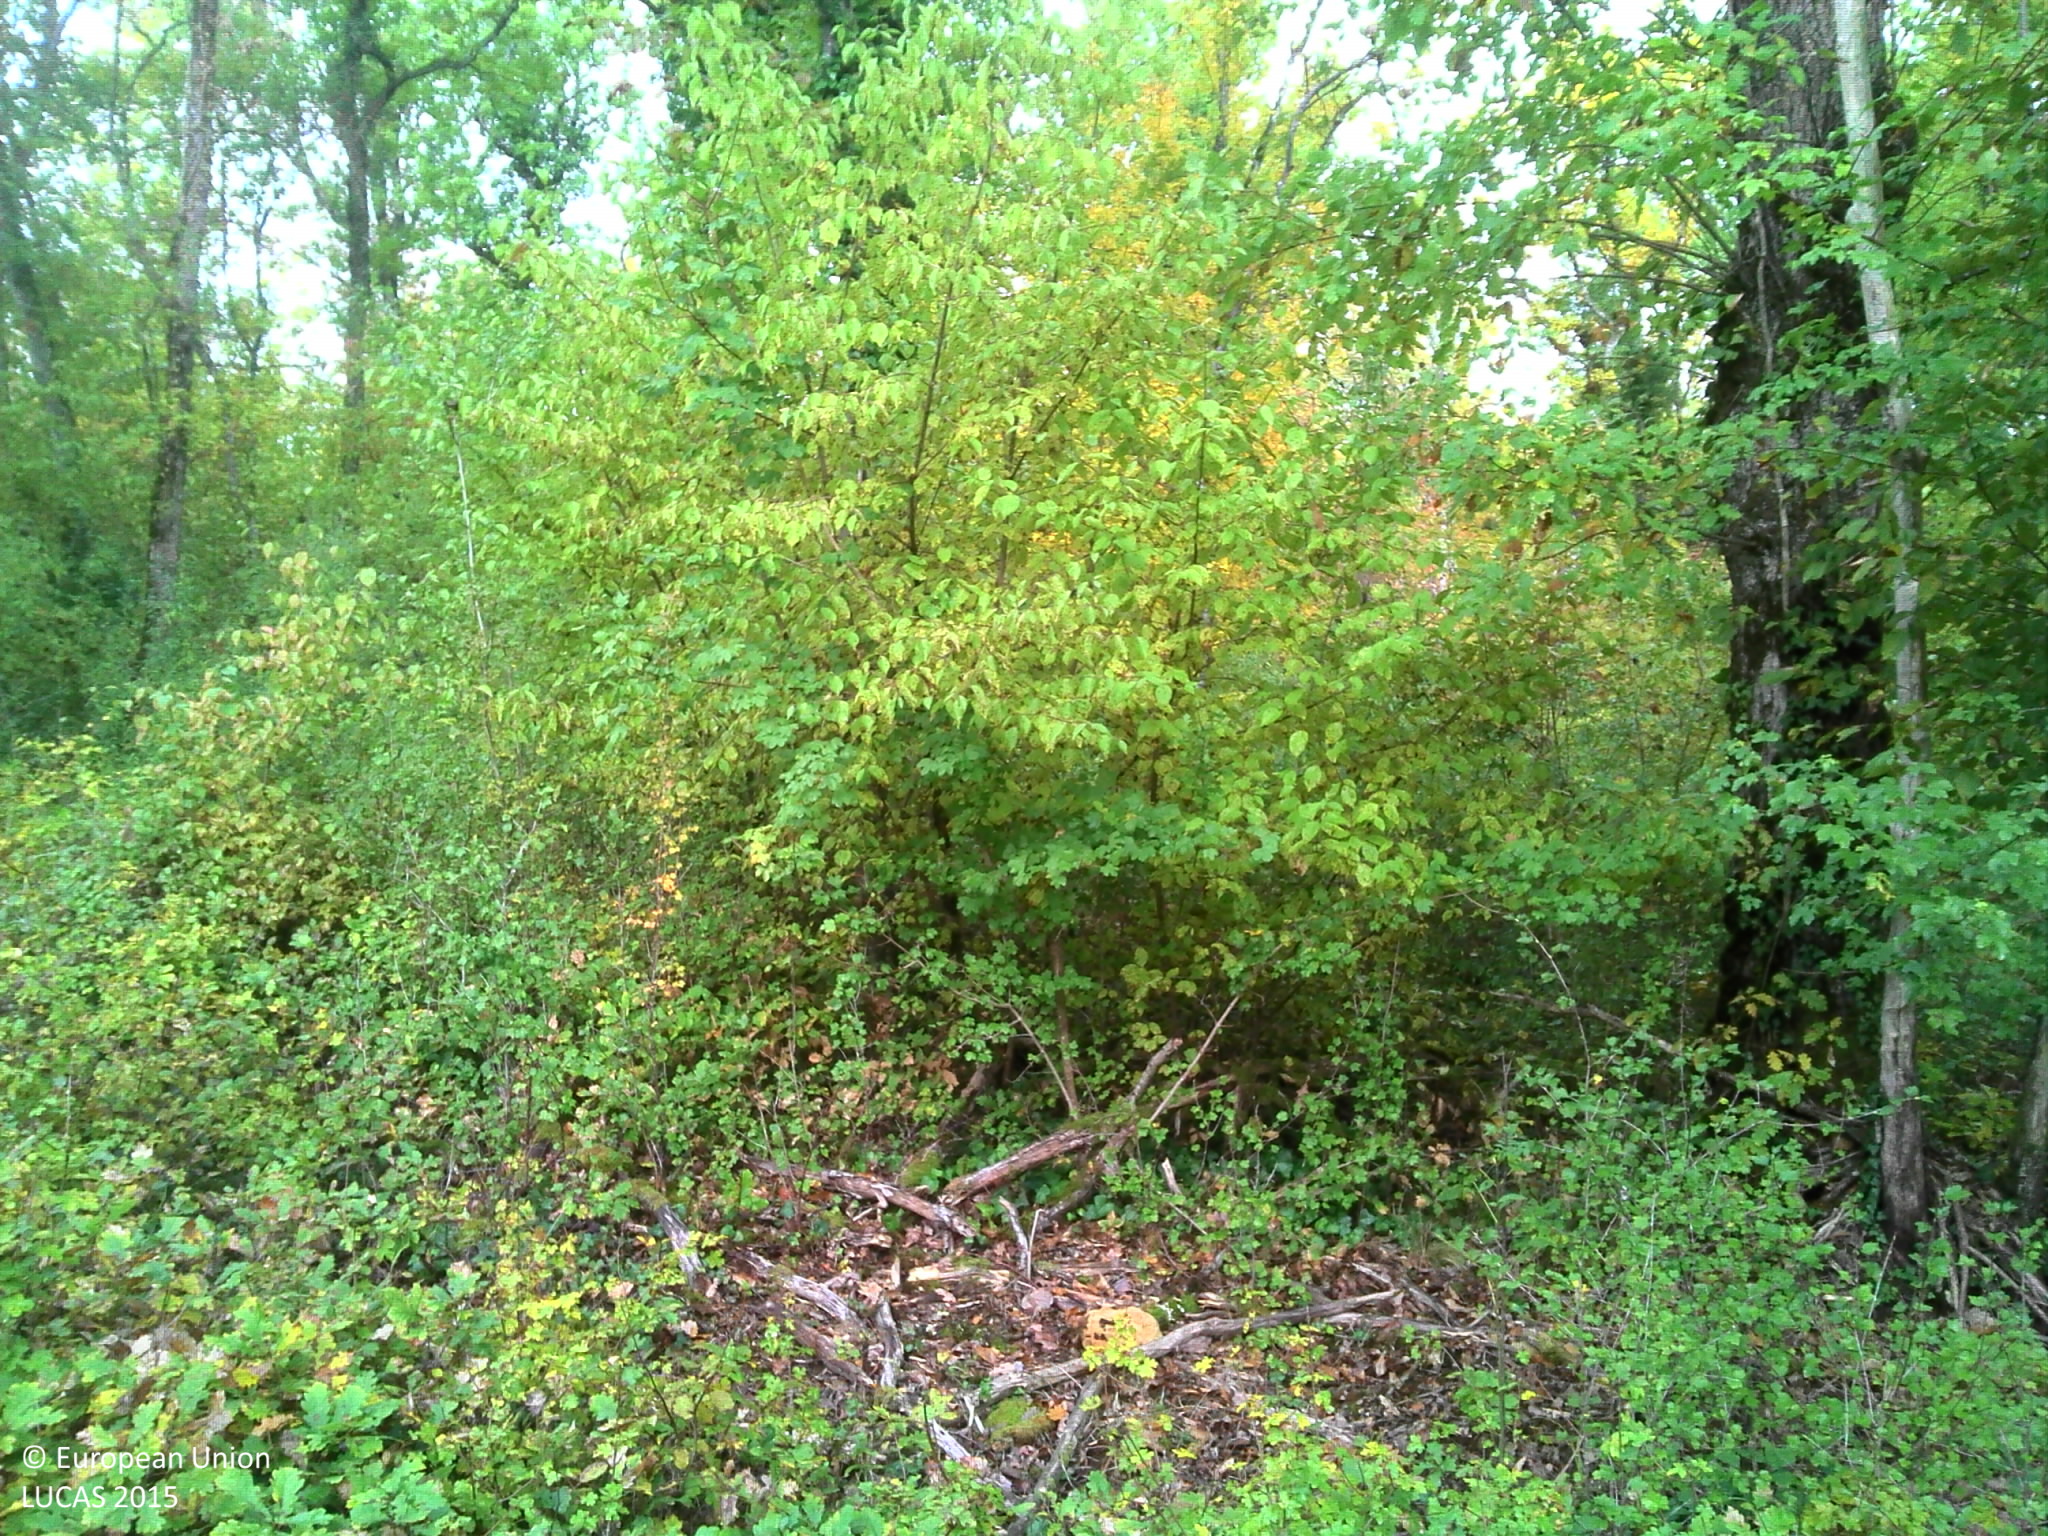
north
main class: Woodland
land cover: Broadleaved woodland
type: mesophytic deciduous forest
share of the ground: > 75 %
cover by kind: broadleaved forest trees 100 %
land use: Forestry
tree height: > 5 m
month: October
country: FR
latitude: 47.3496
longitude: 4.9303
